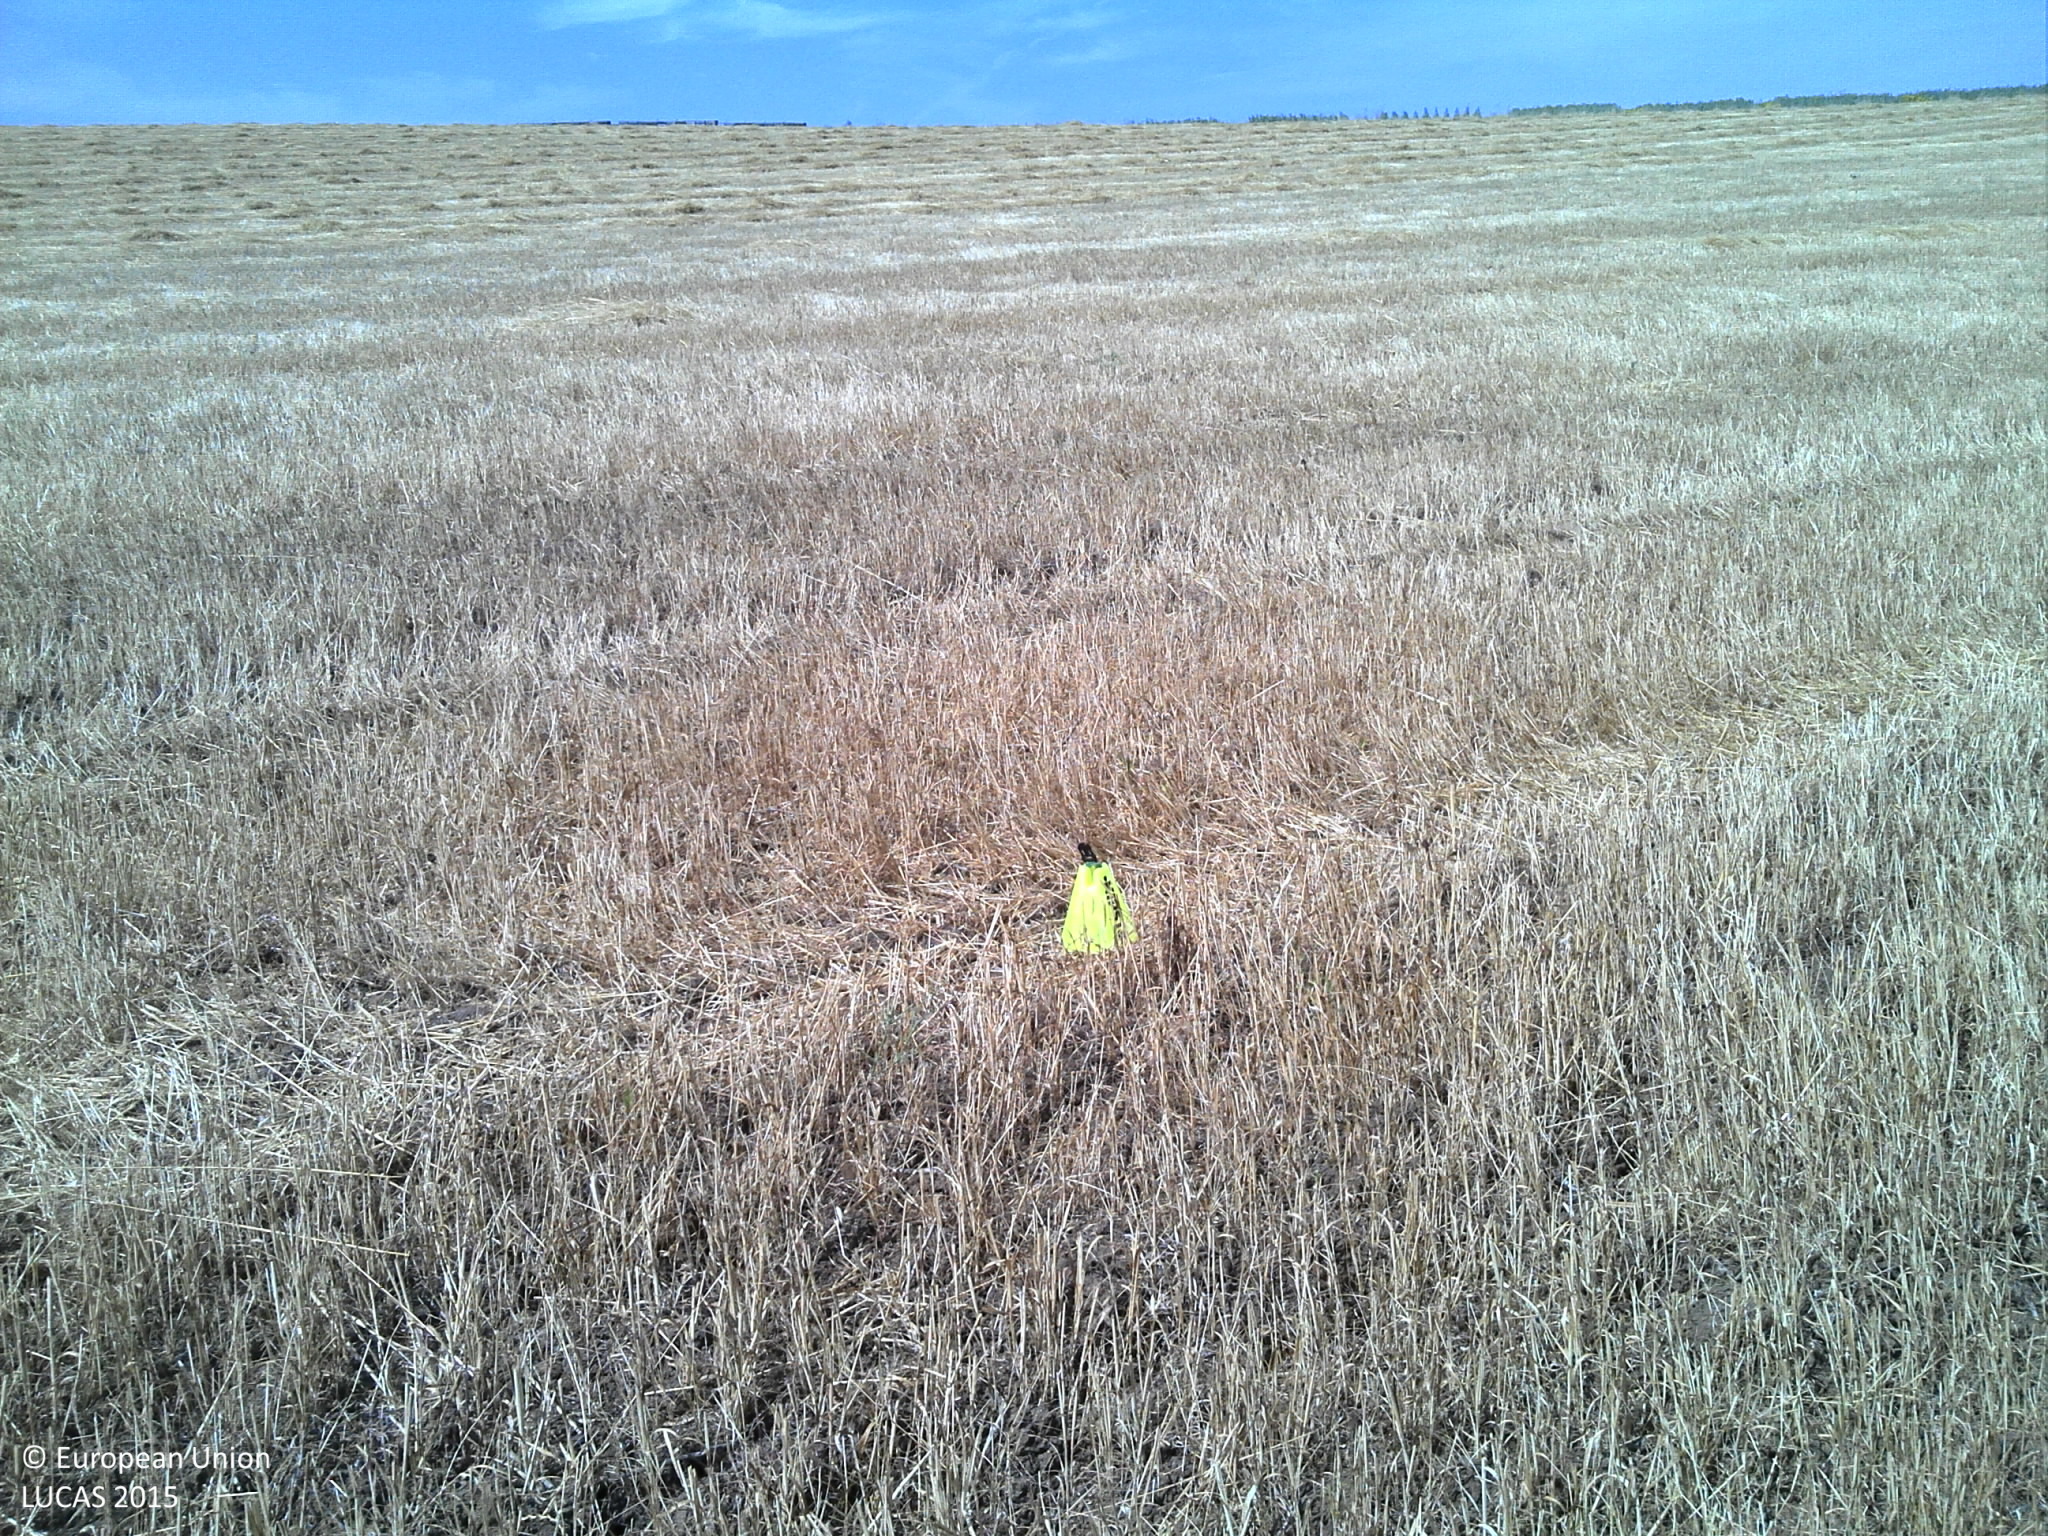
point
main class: Cropland
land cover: Oats
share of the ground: < 10 %
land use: Agriculture (excluding fallow land and kitchen gardens)
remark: Harvested field
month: July
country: PT
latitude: 38.4736
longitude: -7.7193
